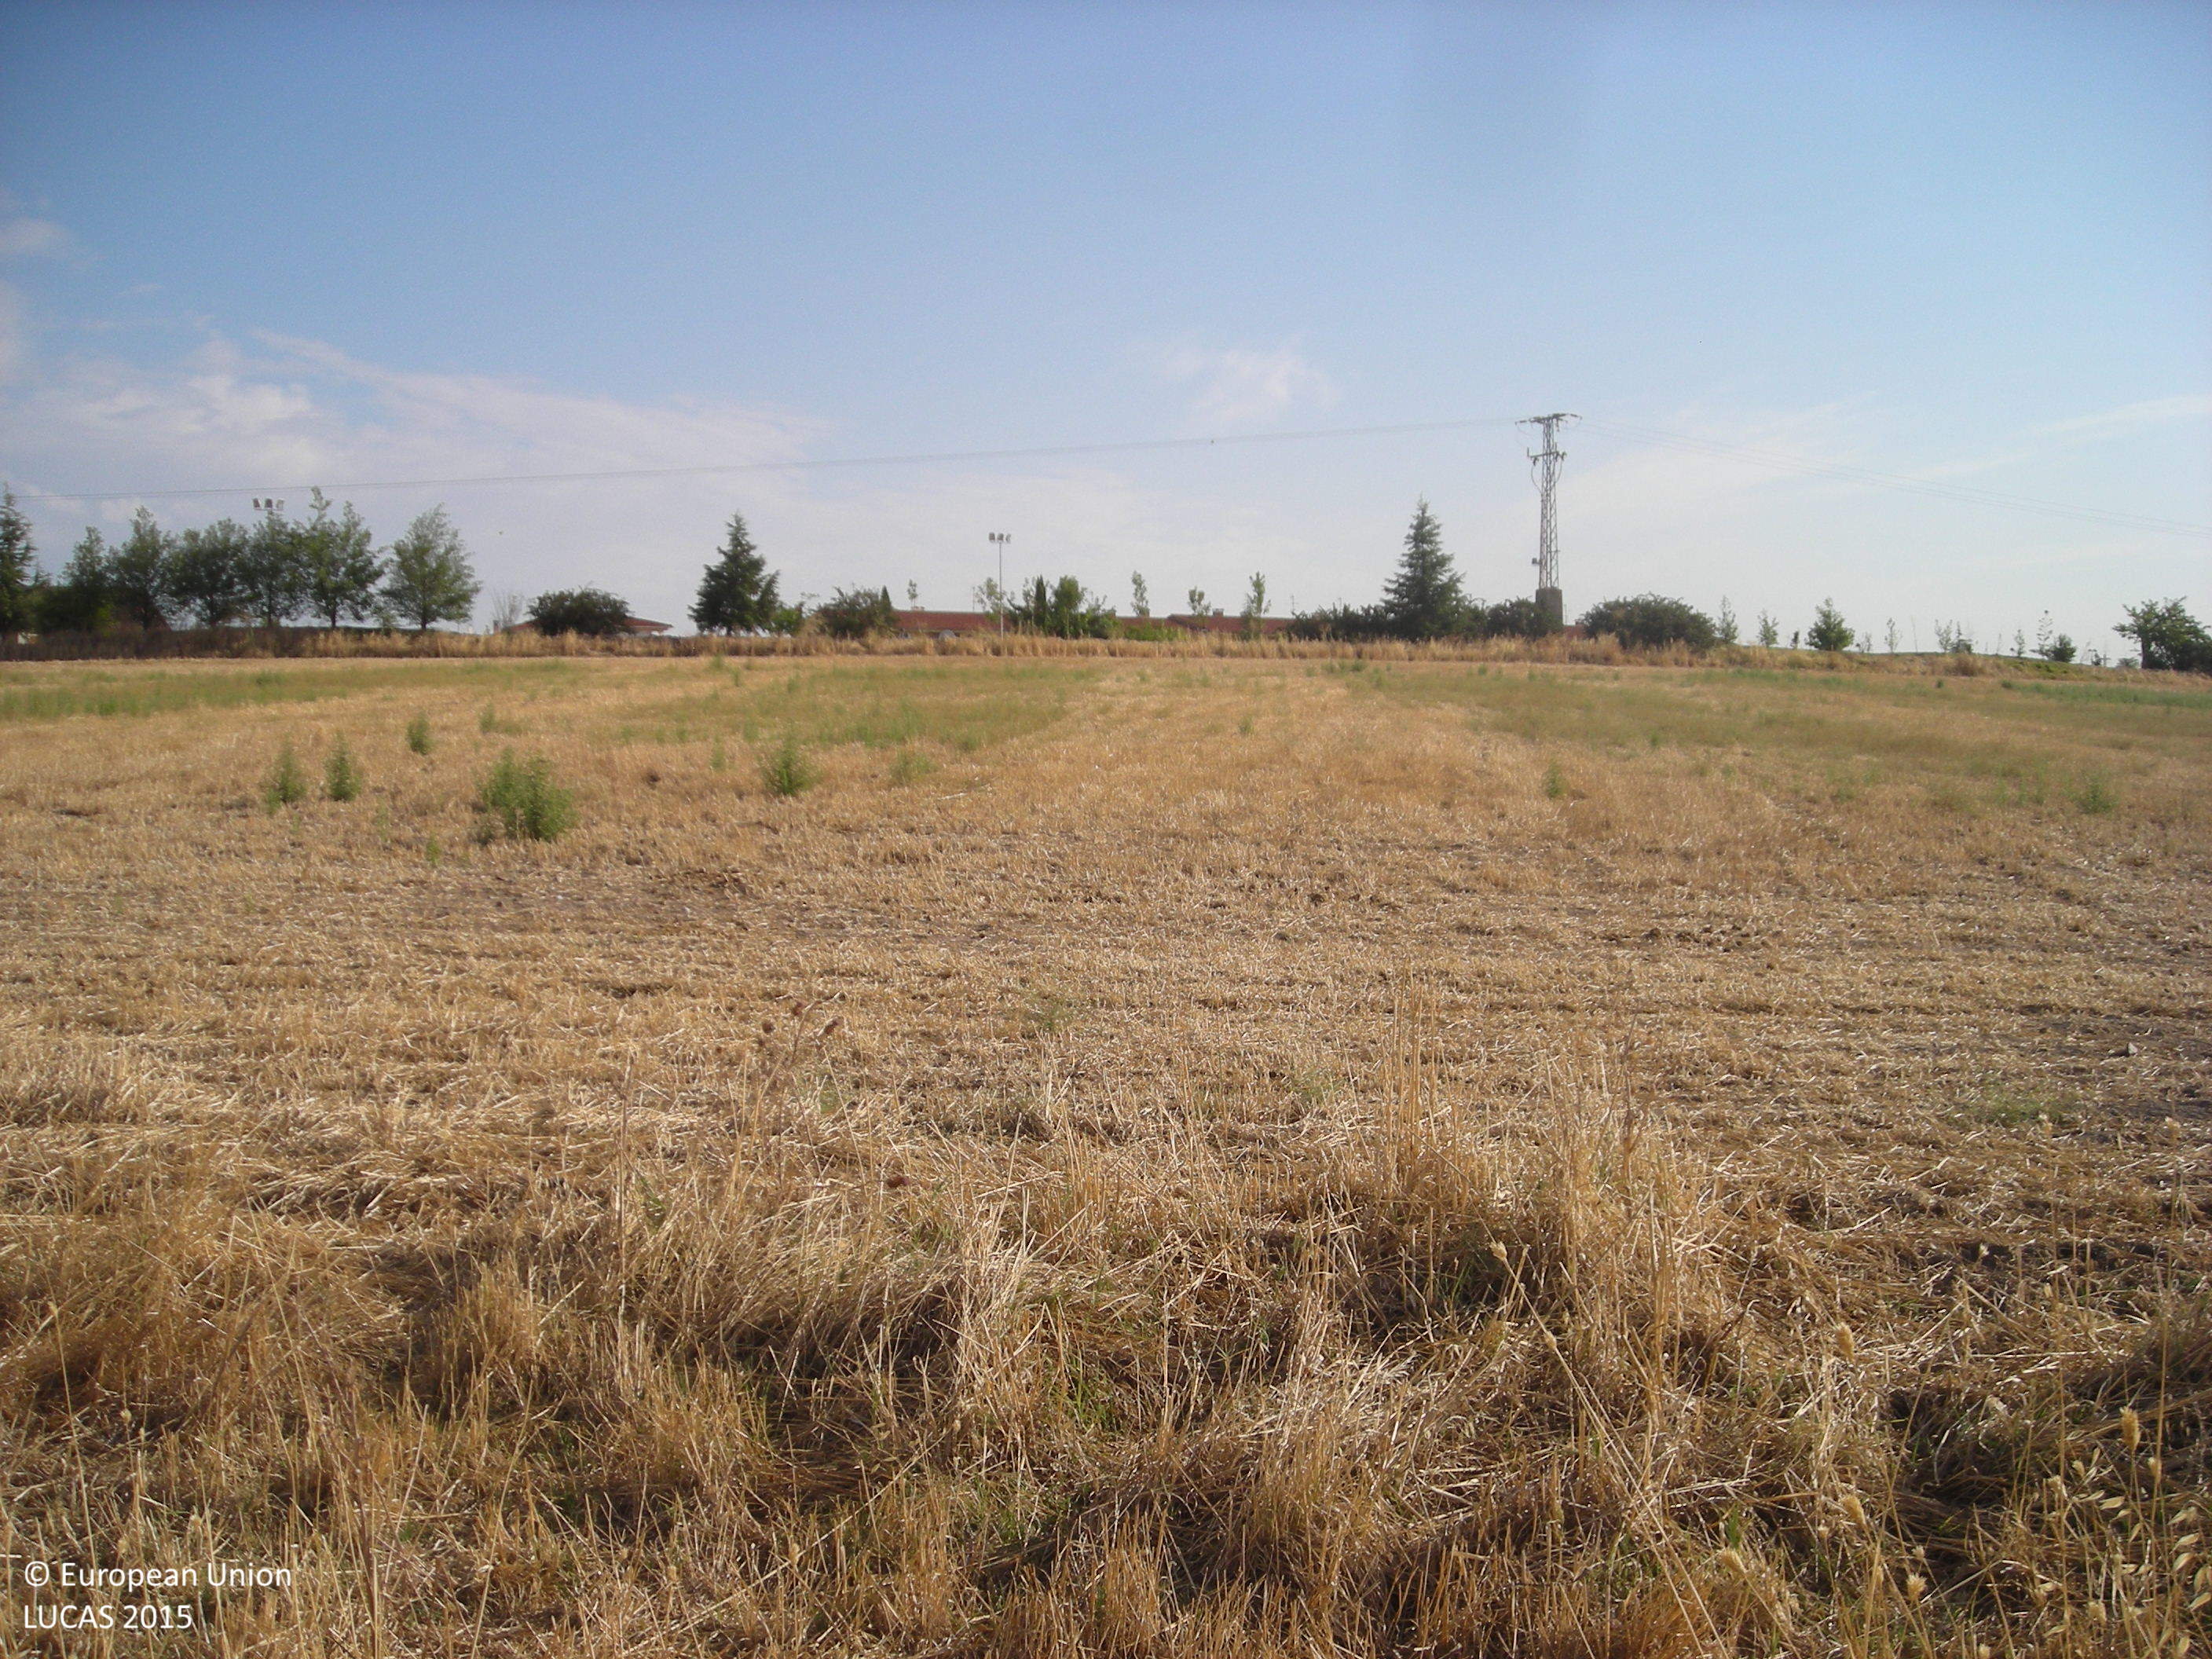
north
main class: Grassland
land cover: Spontaneously vegetated surfaces
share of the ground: 50 - 75 %
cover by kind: herbaceous plants 100 %
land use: Abandoned areas
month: July
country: ES
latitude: 39.1427
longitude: -5.9159
